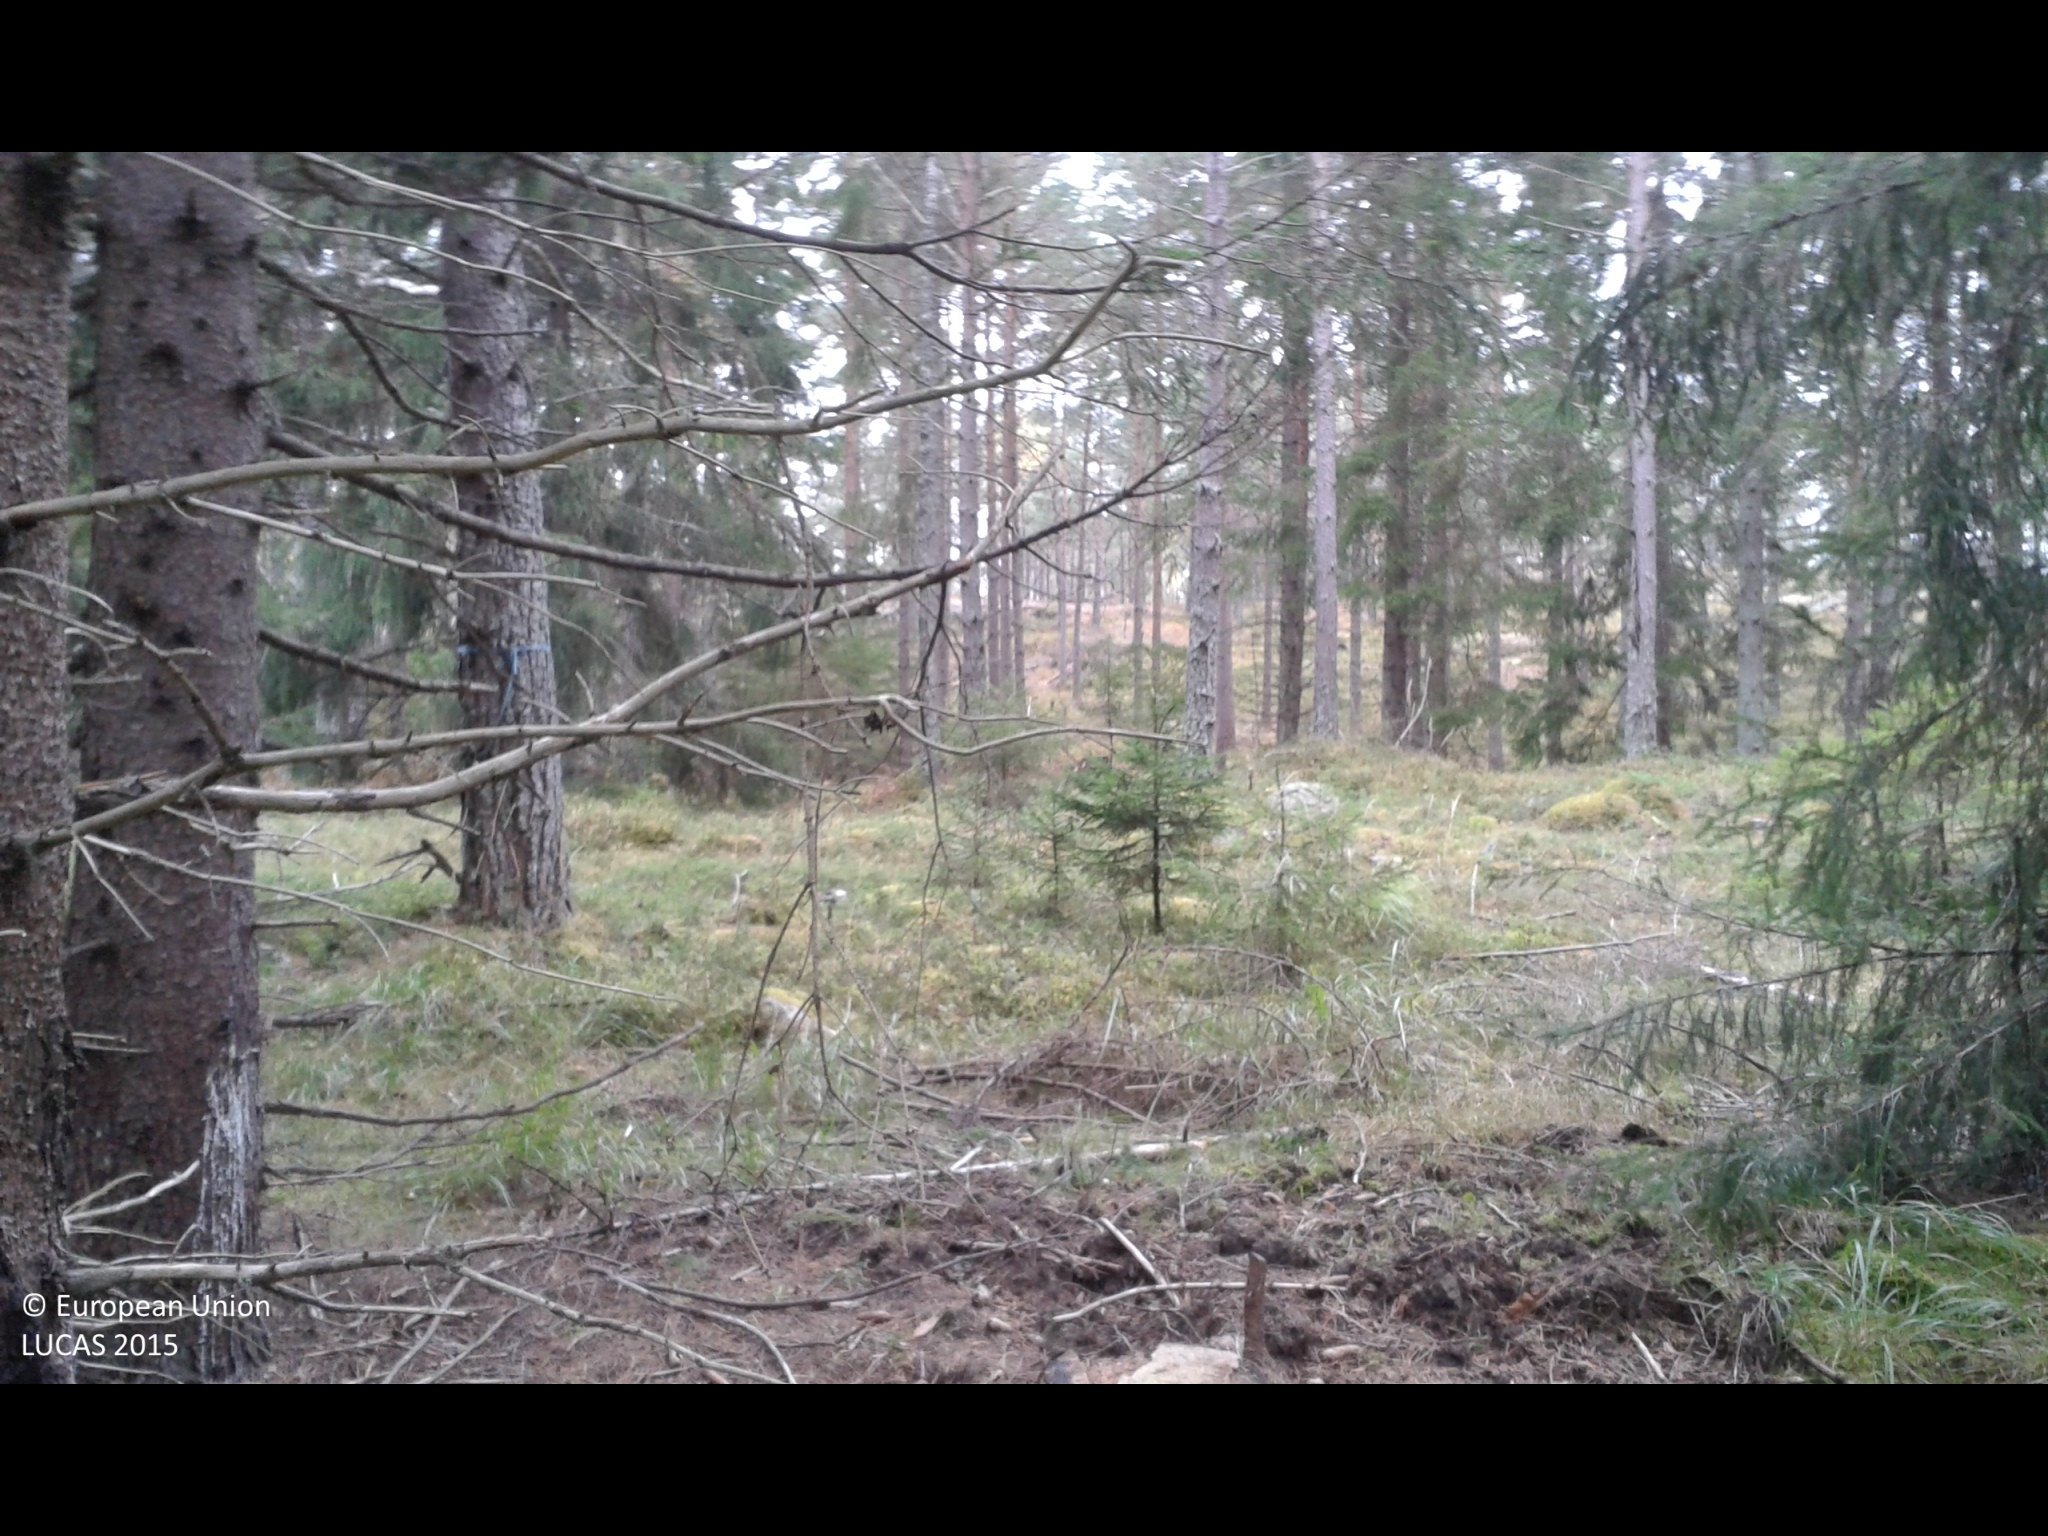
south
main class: Woodland
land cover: Spruce dominated coniferous woodland
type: boreal forest
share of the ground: 50 - 75 %
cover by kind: coniferous forest trees 70 %, herbaceous plants 30 %
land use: Forestry
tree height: > 5 m
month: October
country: SE
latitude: 58.7830
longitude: 17.2456
